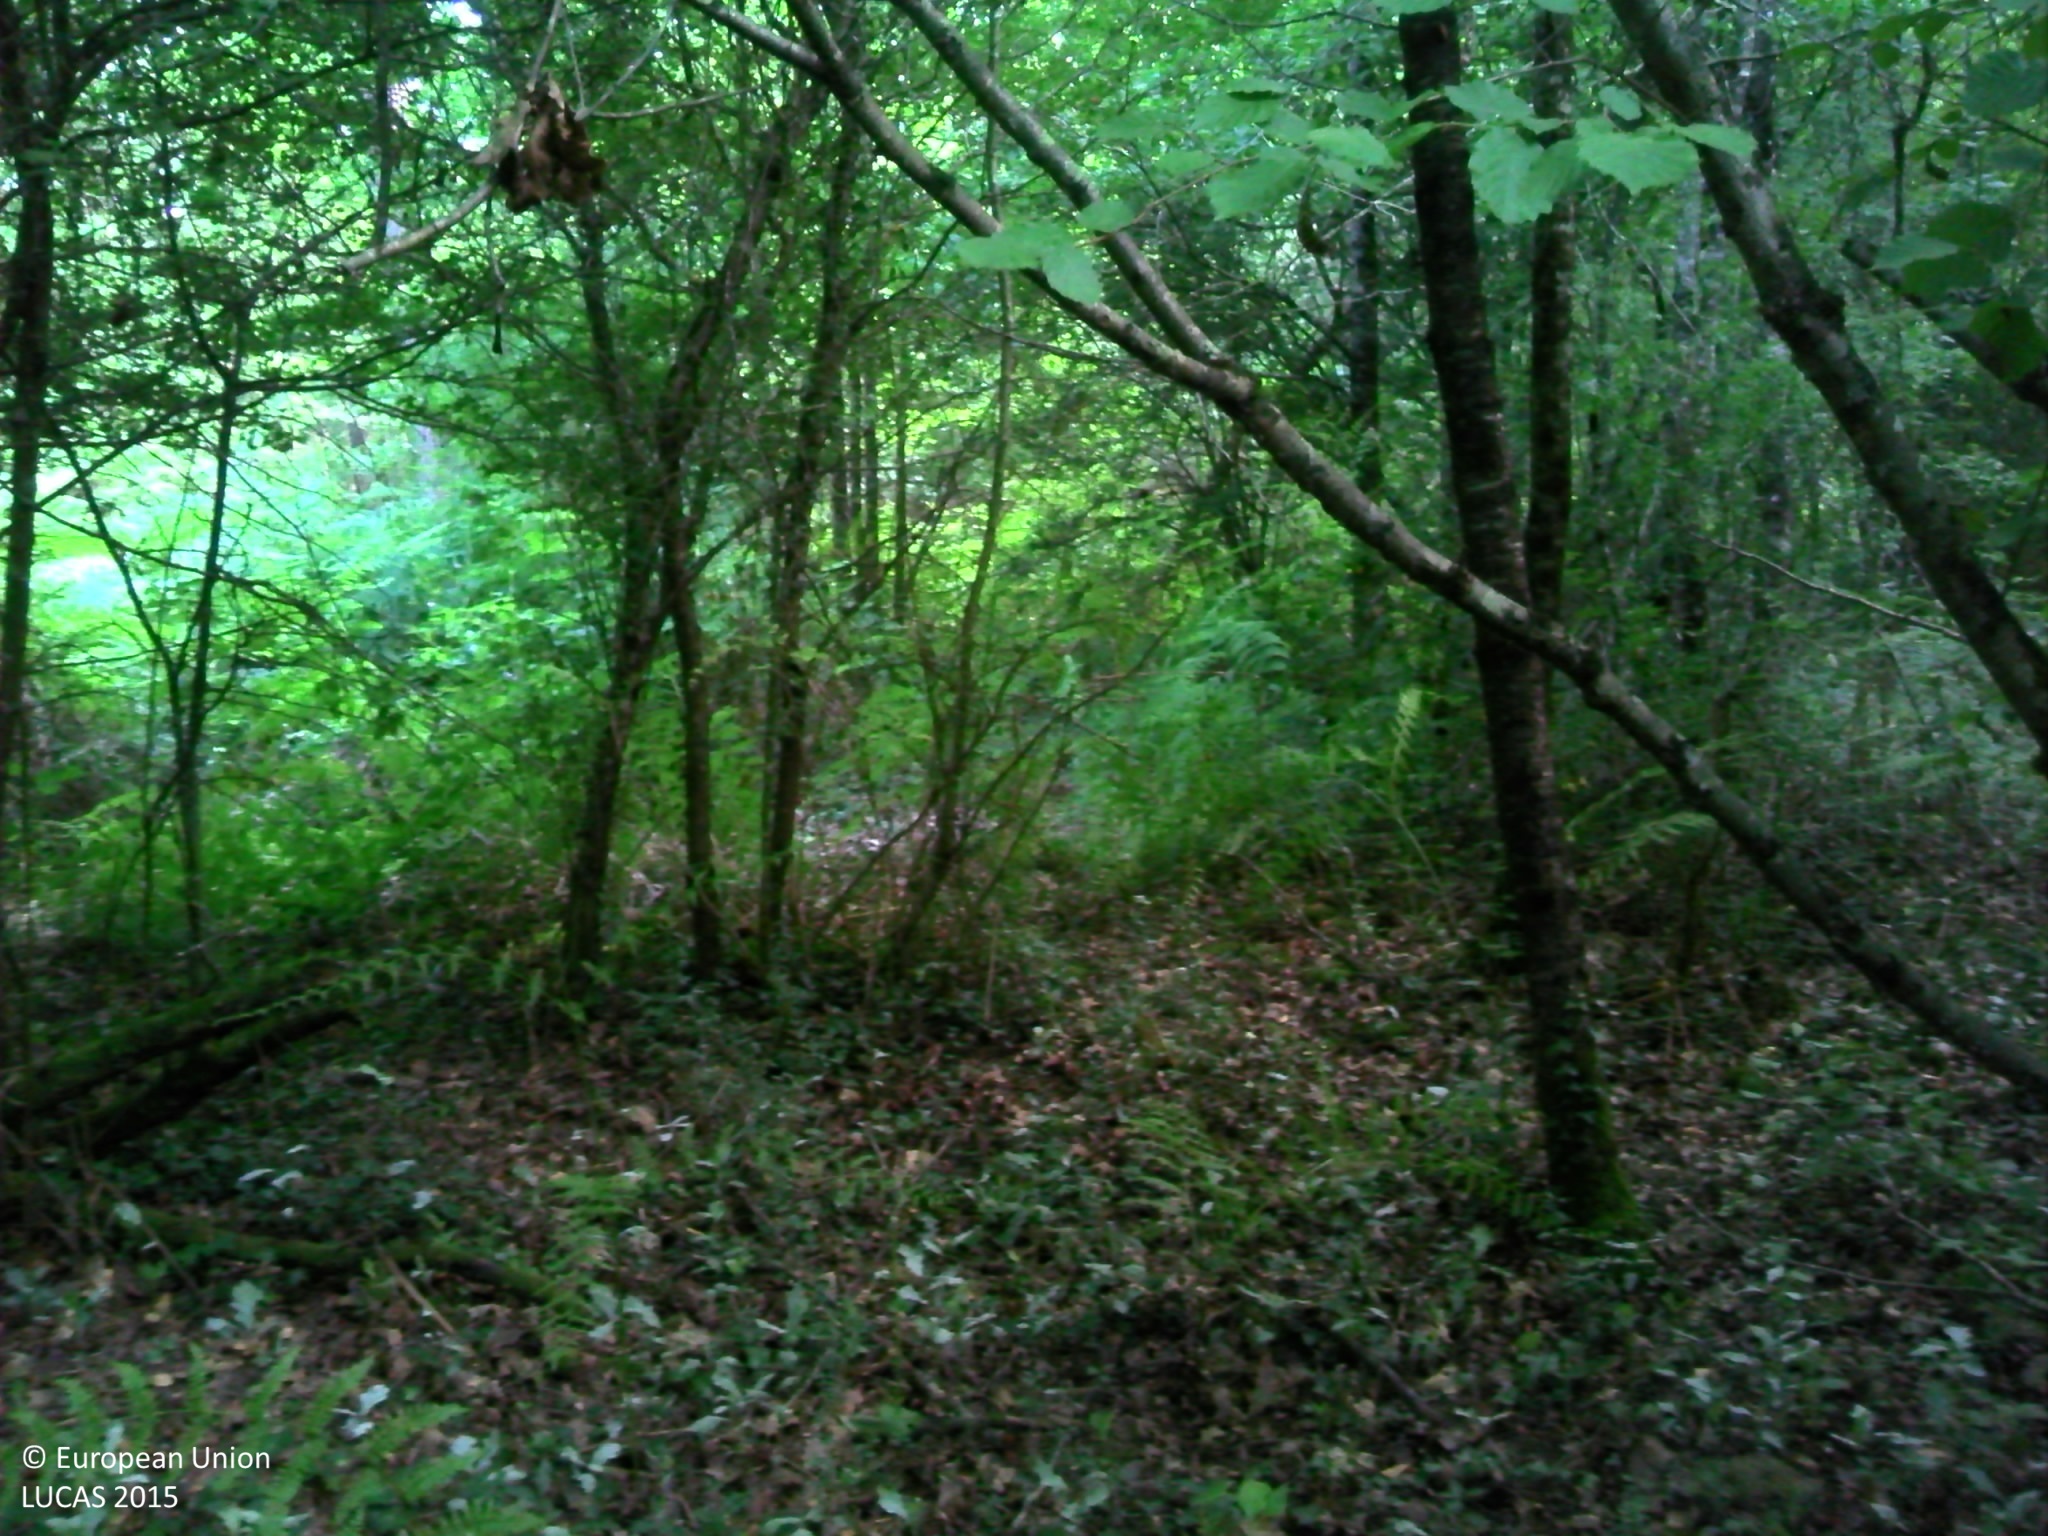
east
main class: Woodland
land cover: Broadleaved woodland
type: mesophytic deciduous forest
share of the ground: > 75 %
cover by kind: broadleaved forest trees 80 %, coniferous forest trees 10 %, shrubs 5 %, herbaceous plants 5 %
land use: Forestry
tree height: > 5 m
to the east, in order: Broadleaved woodland; Grassland without tree/shrub cover; Lines of trees; Fences; Grassland without tree/shrub cover; Fences; Broadleaved woodland
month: June
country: FR
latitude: 46.8055
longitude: 0.7979
